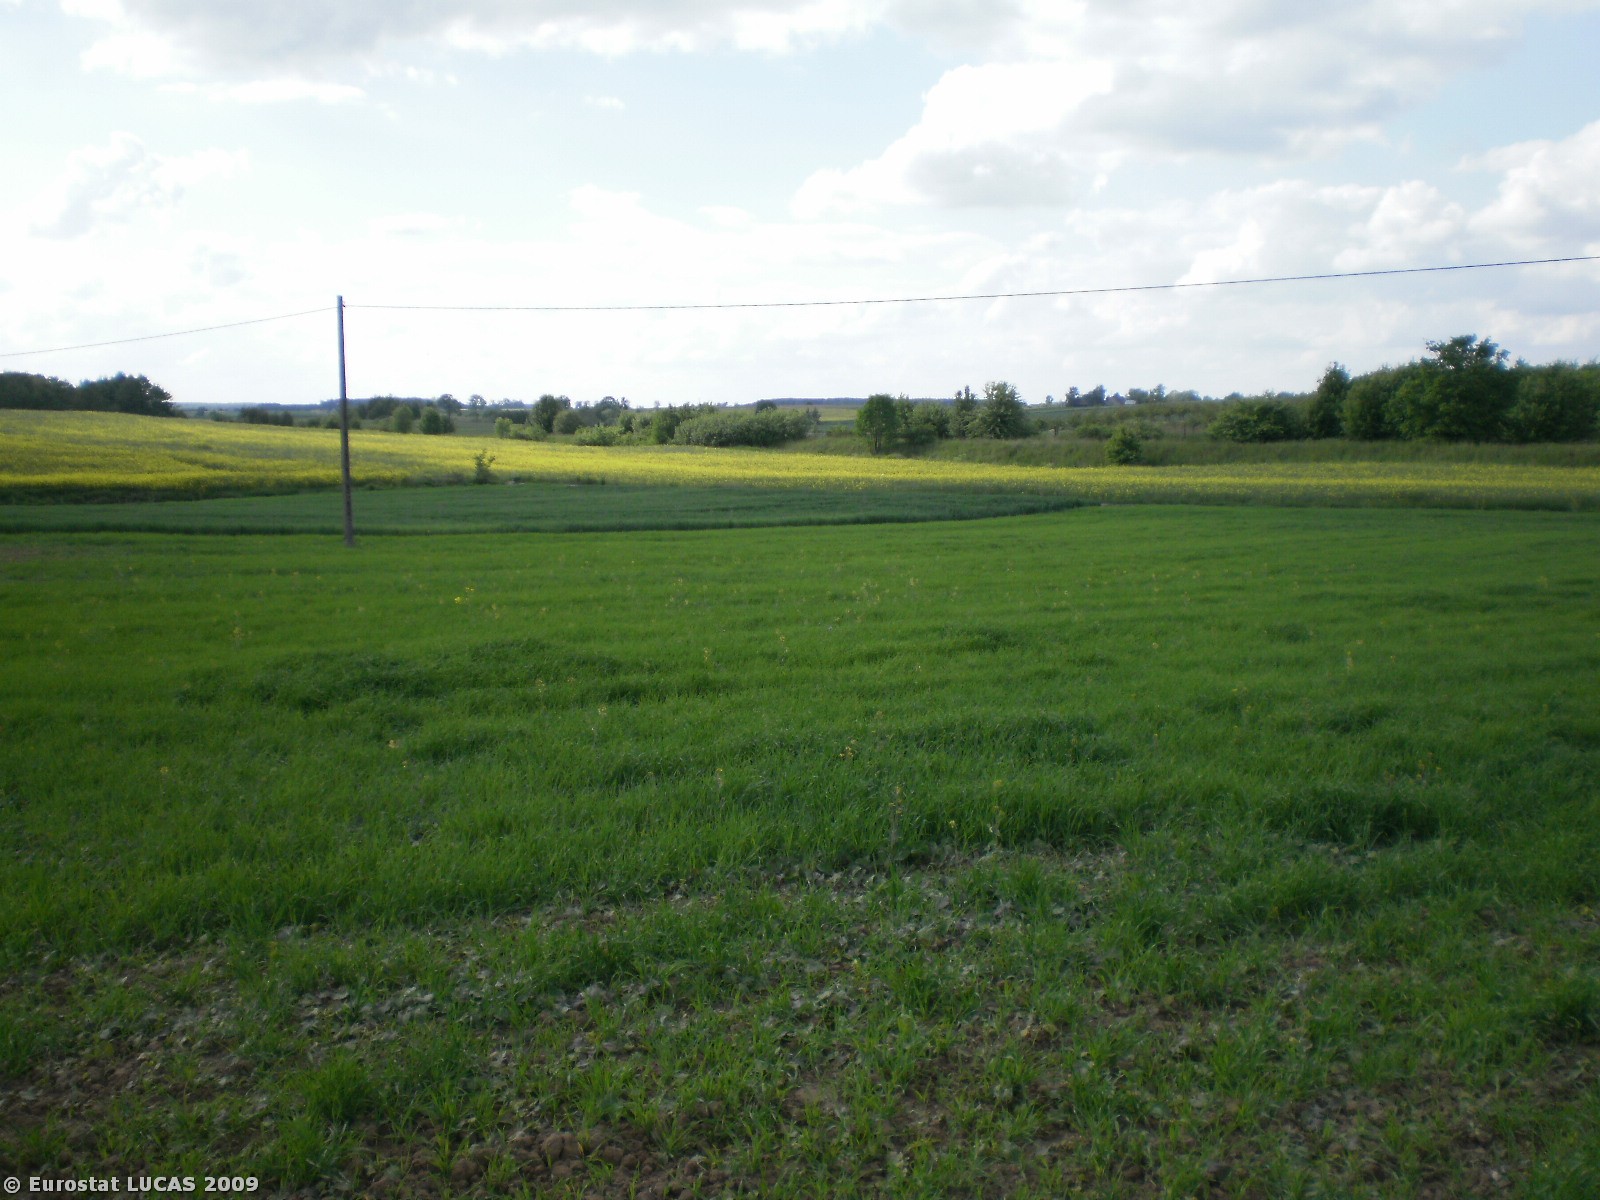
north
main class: Cropland
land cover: Barley
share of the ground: > 75 %
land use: Agriculture (excluding fallow land and kitchen gardens)
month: May
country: PL
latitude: 53.4433
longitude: 17.7366
